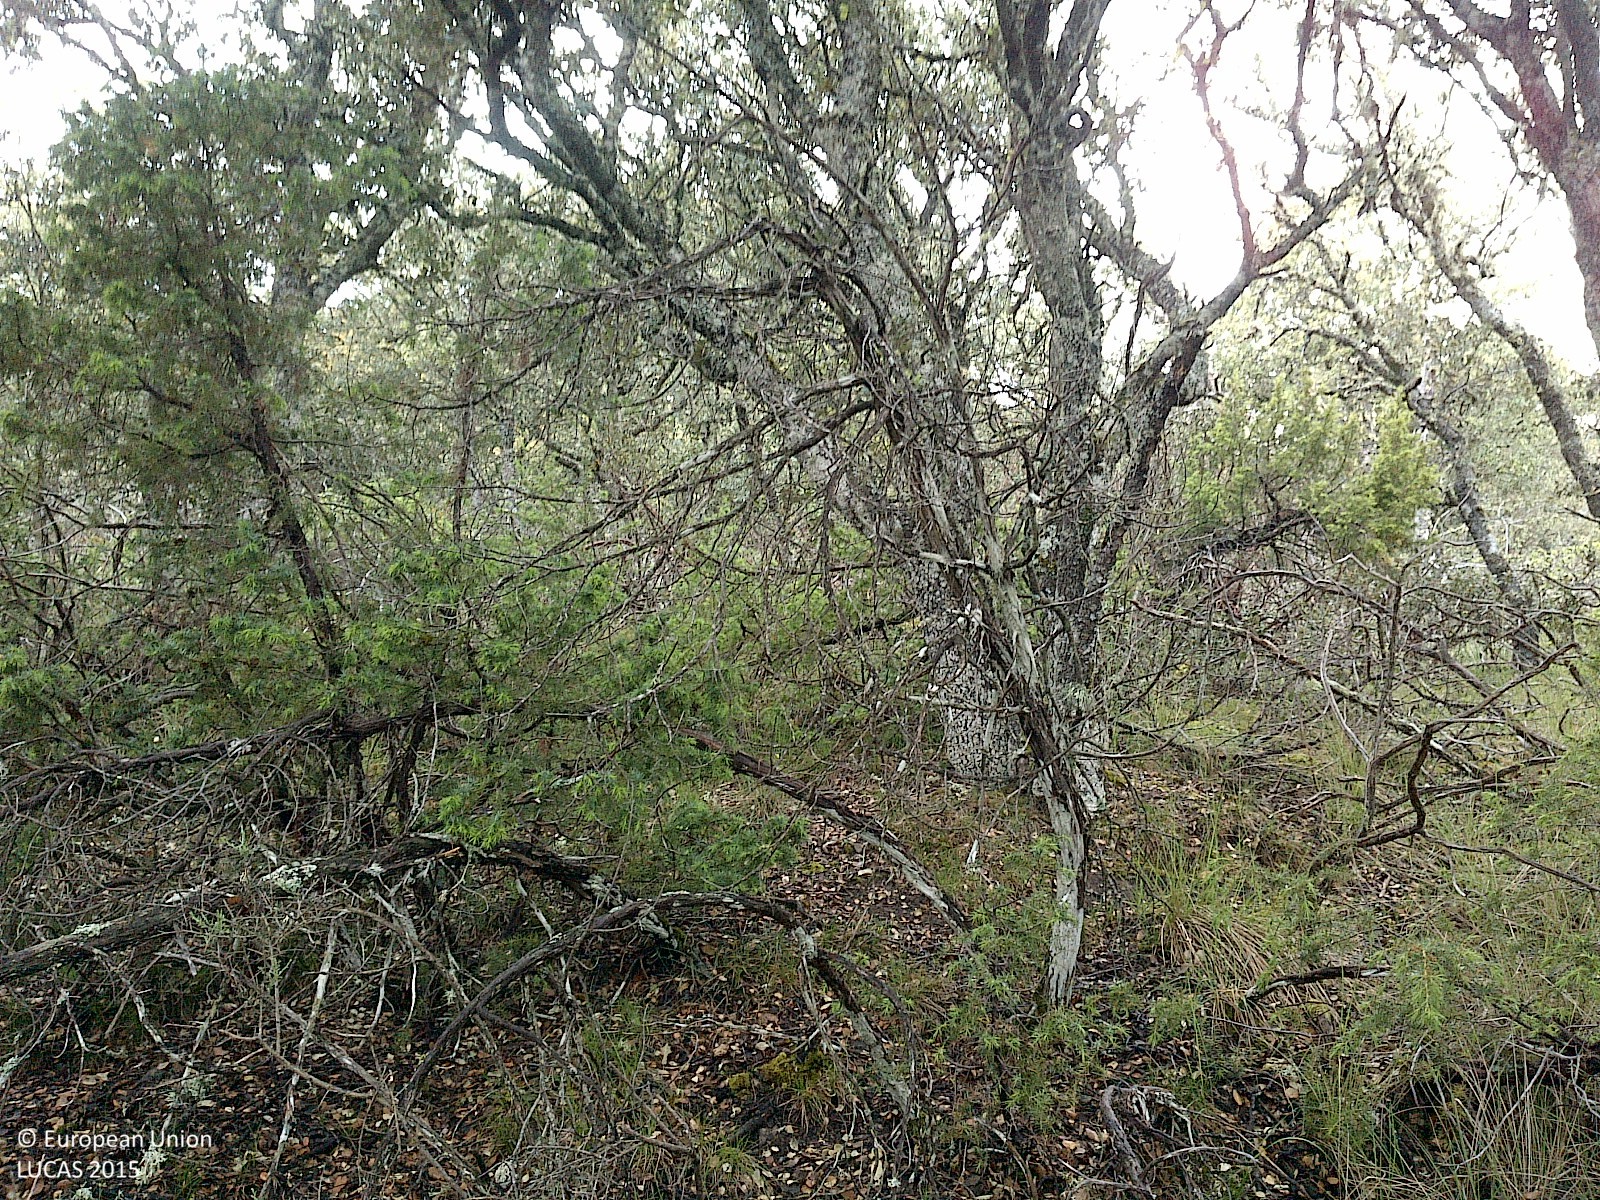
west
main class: Woodland
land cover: Broadleaved woodland
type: broadleaved evergreen forest
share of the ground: > 75 %
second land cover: Grassland without tree/shrub cover
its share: 25 - 50 %
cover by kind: broadleaved forest trees 80 %, shrubs 15 %, herbaceous plants 5 %
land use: Forestry
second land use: Agriculture (excluding fallow land and kitchen gardens)
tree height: > 5 m
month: May
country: ES
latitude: 41.8065
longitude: -2.1799
